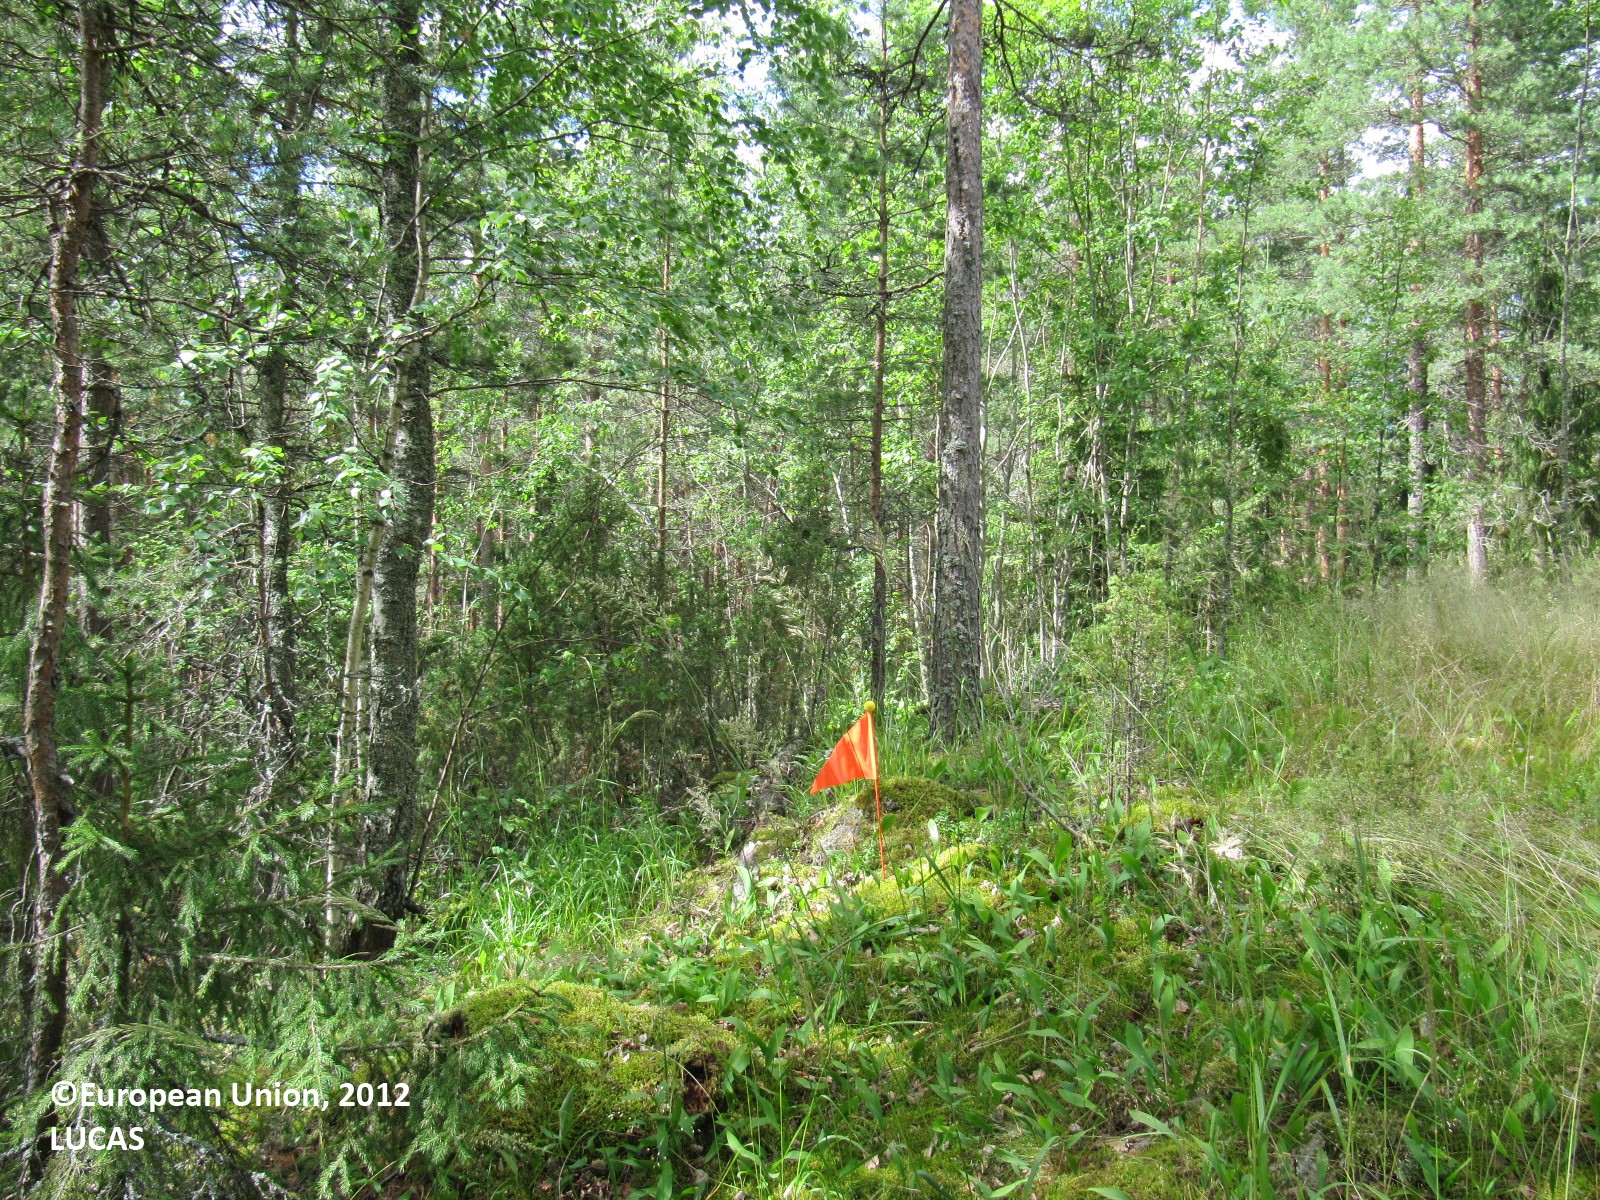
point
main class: Woodland
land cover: Pine dominated mixed woodland
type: boreal forest
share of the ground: 50 - 75 %
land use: Forestry
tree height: > 5 m
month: July
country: FI
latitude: 60.7533
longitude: 24.6209
